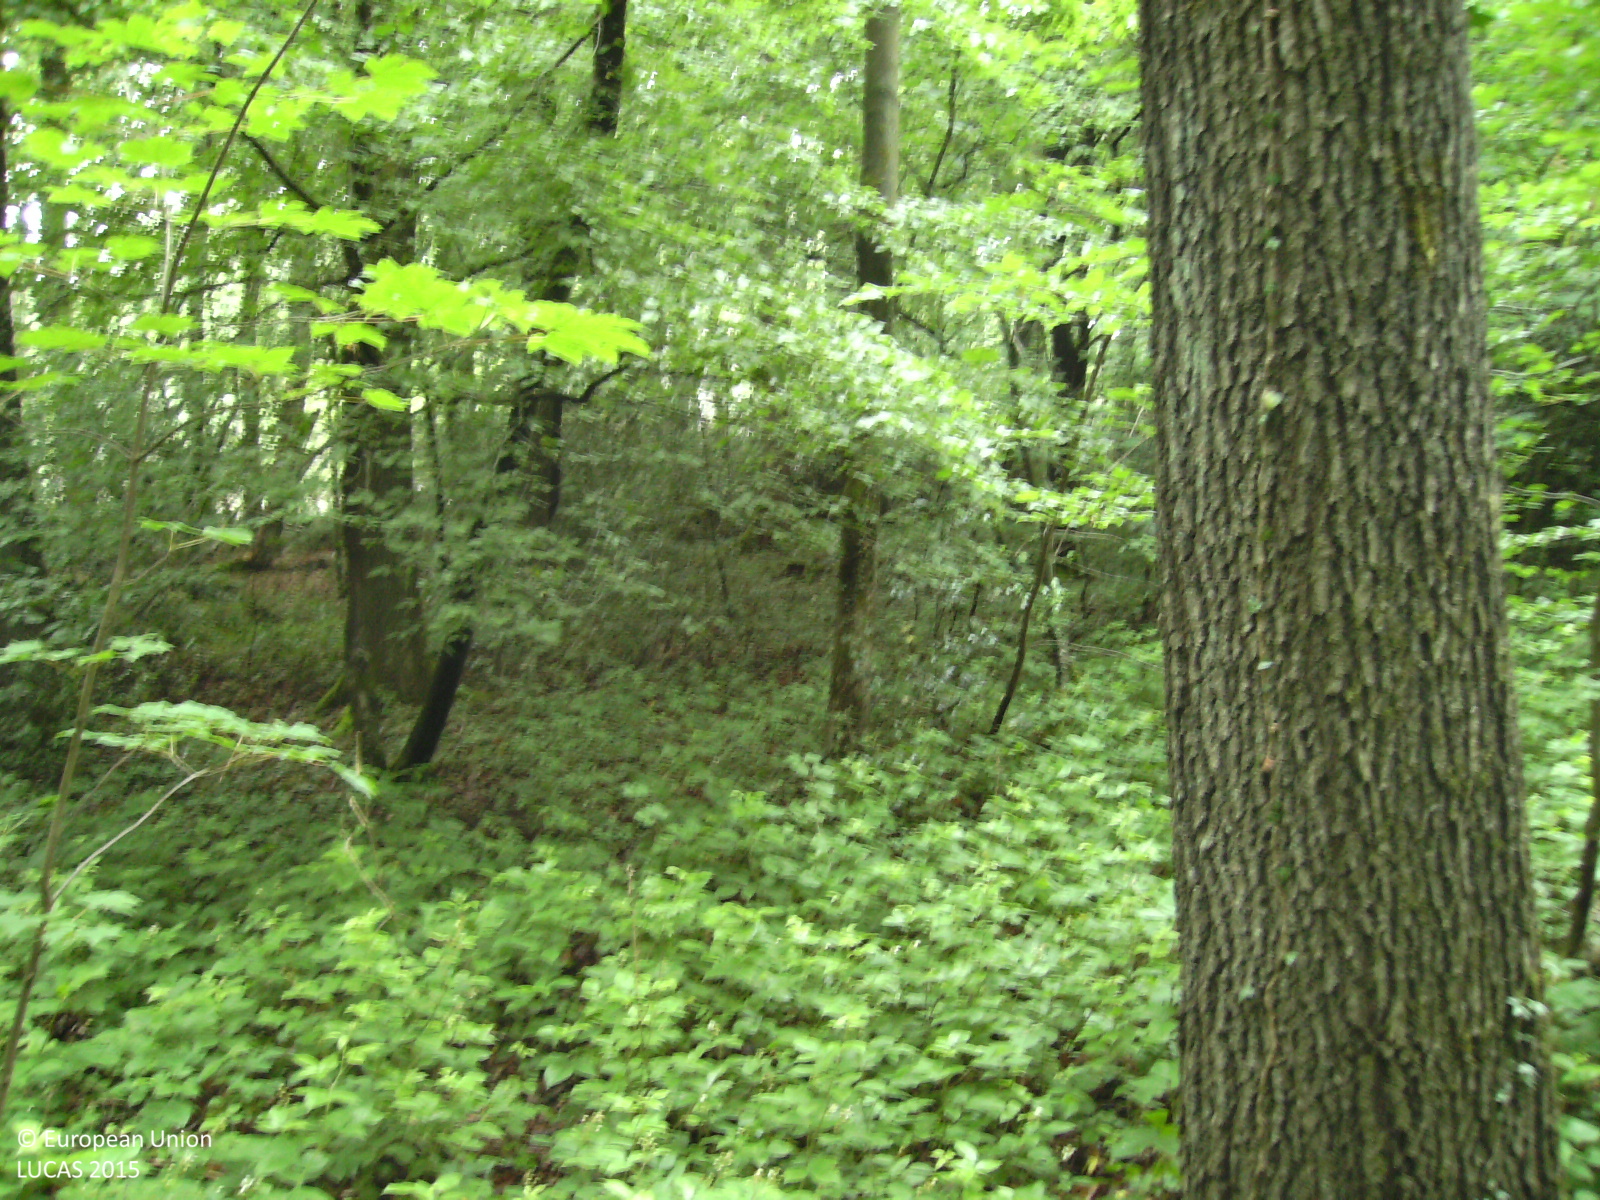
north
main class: Woodland
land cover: Broadleaved woodland
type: mesophytic deciduous forest
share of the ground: > 75 %
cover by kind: broadleaved forest trees 100 %
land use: Forestry
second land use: Amenities, museums, leisure
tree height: > 5 m
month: June
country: DE
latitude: 51.2253
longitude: 7.0359
